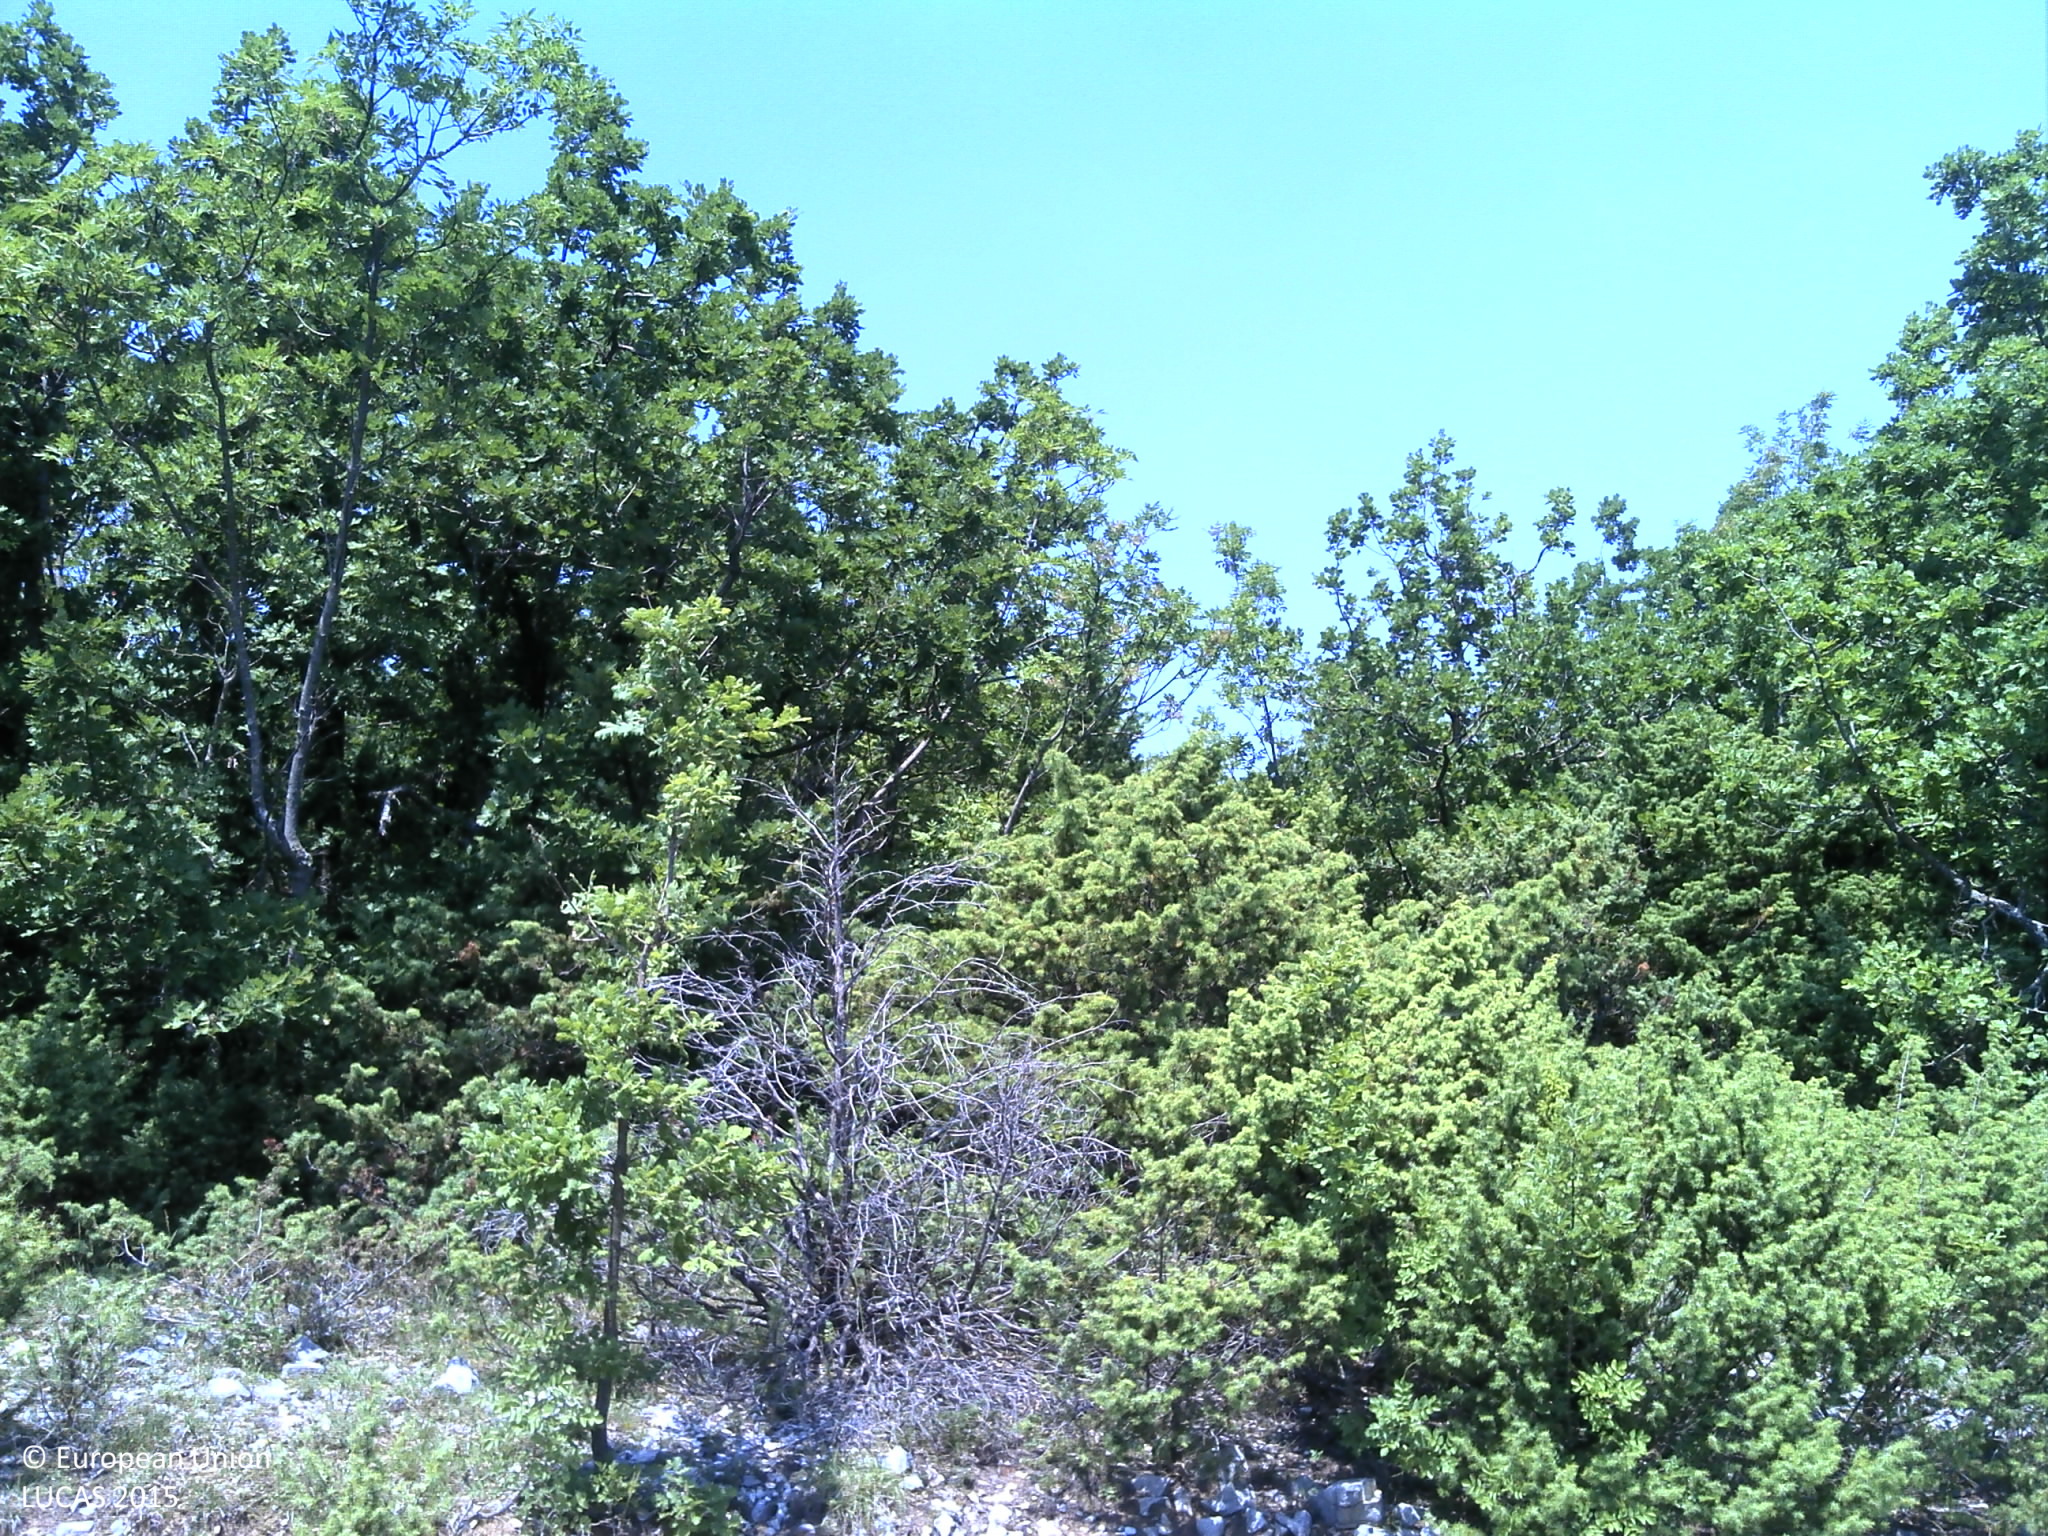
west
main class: Woodland
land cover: Broadleaved woodland
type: thermophilous deciduous forest
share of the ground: 50 - 75 %
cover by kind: broadleaved forest trees 60 %, shrubs 25 %, unconsolidated bare surface 10 %, consolidated bare surface 5 %
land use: Semi-natural and natural areas not in use
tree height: > 5 m
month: June
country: HR
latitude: 43.6015
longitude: 16.2470
